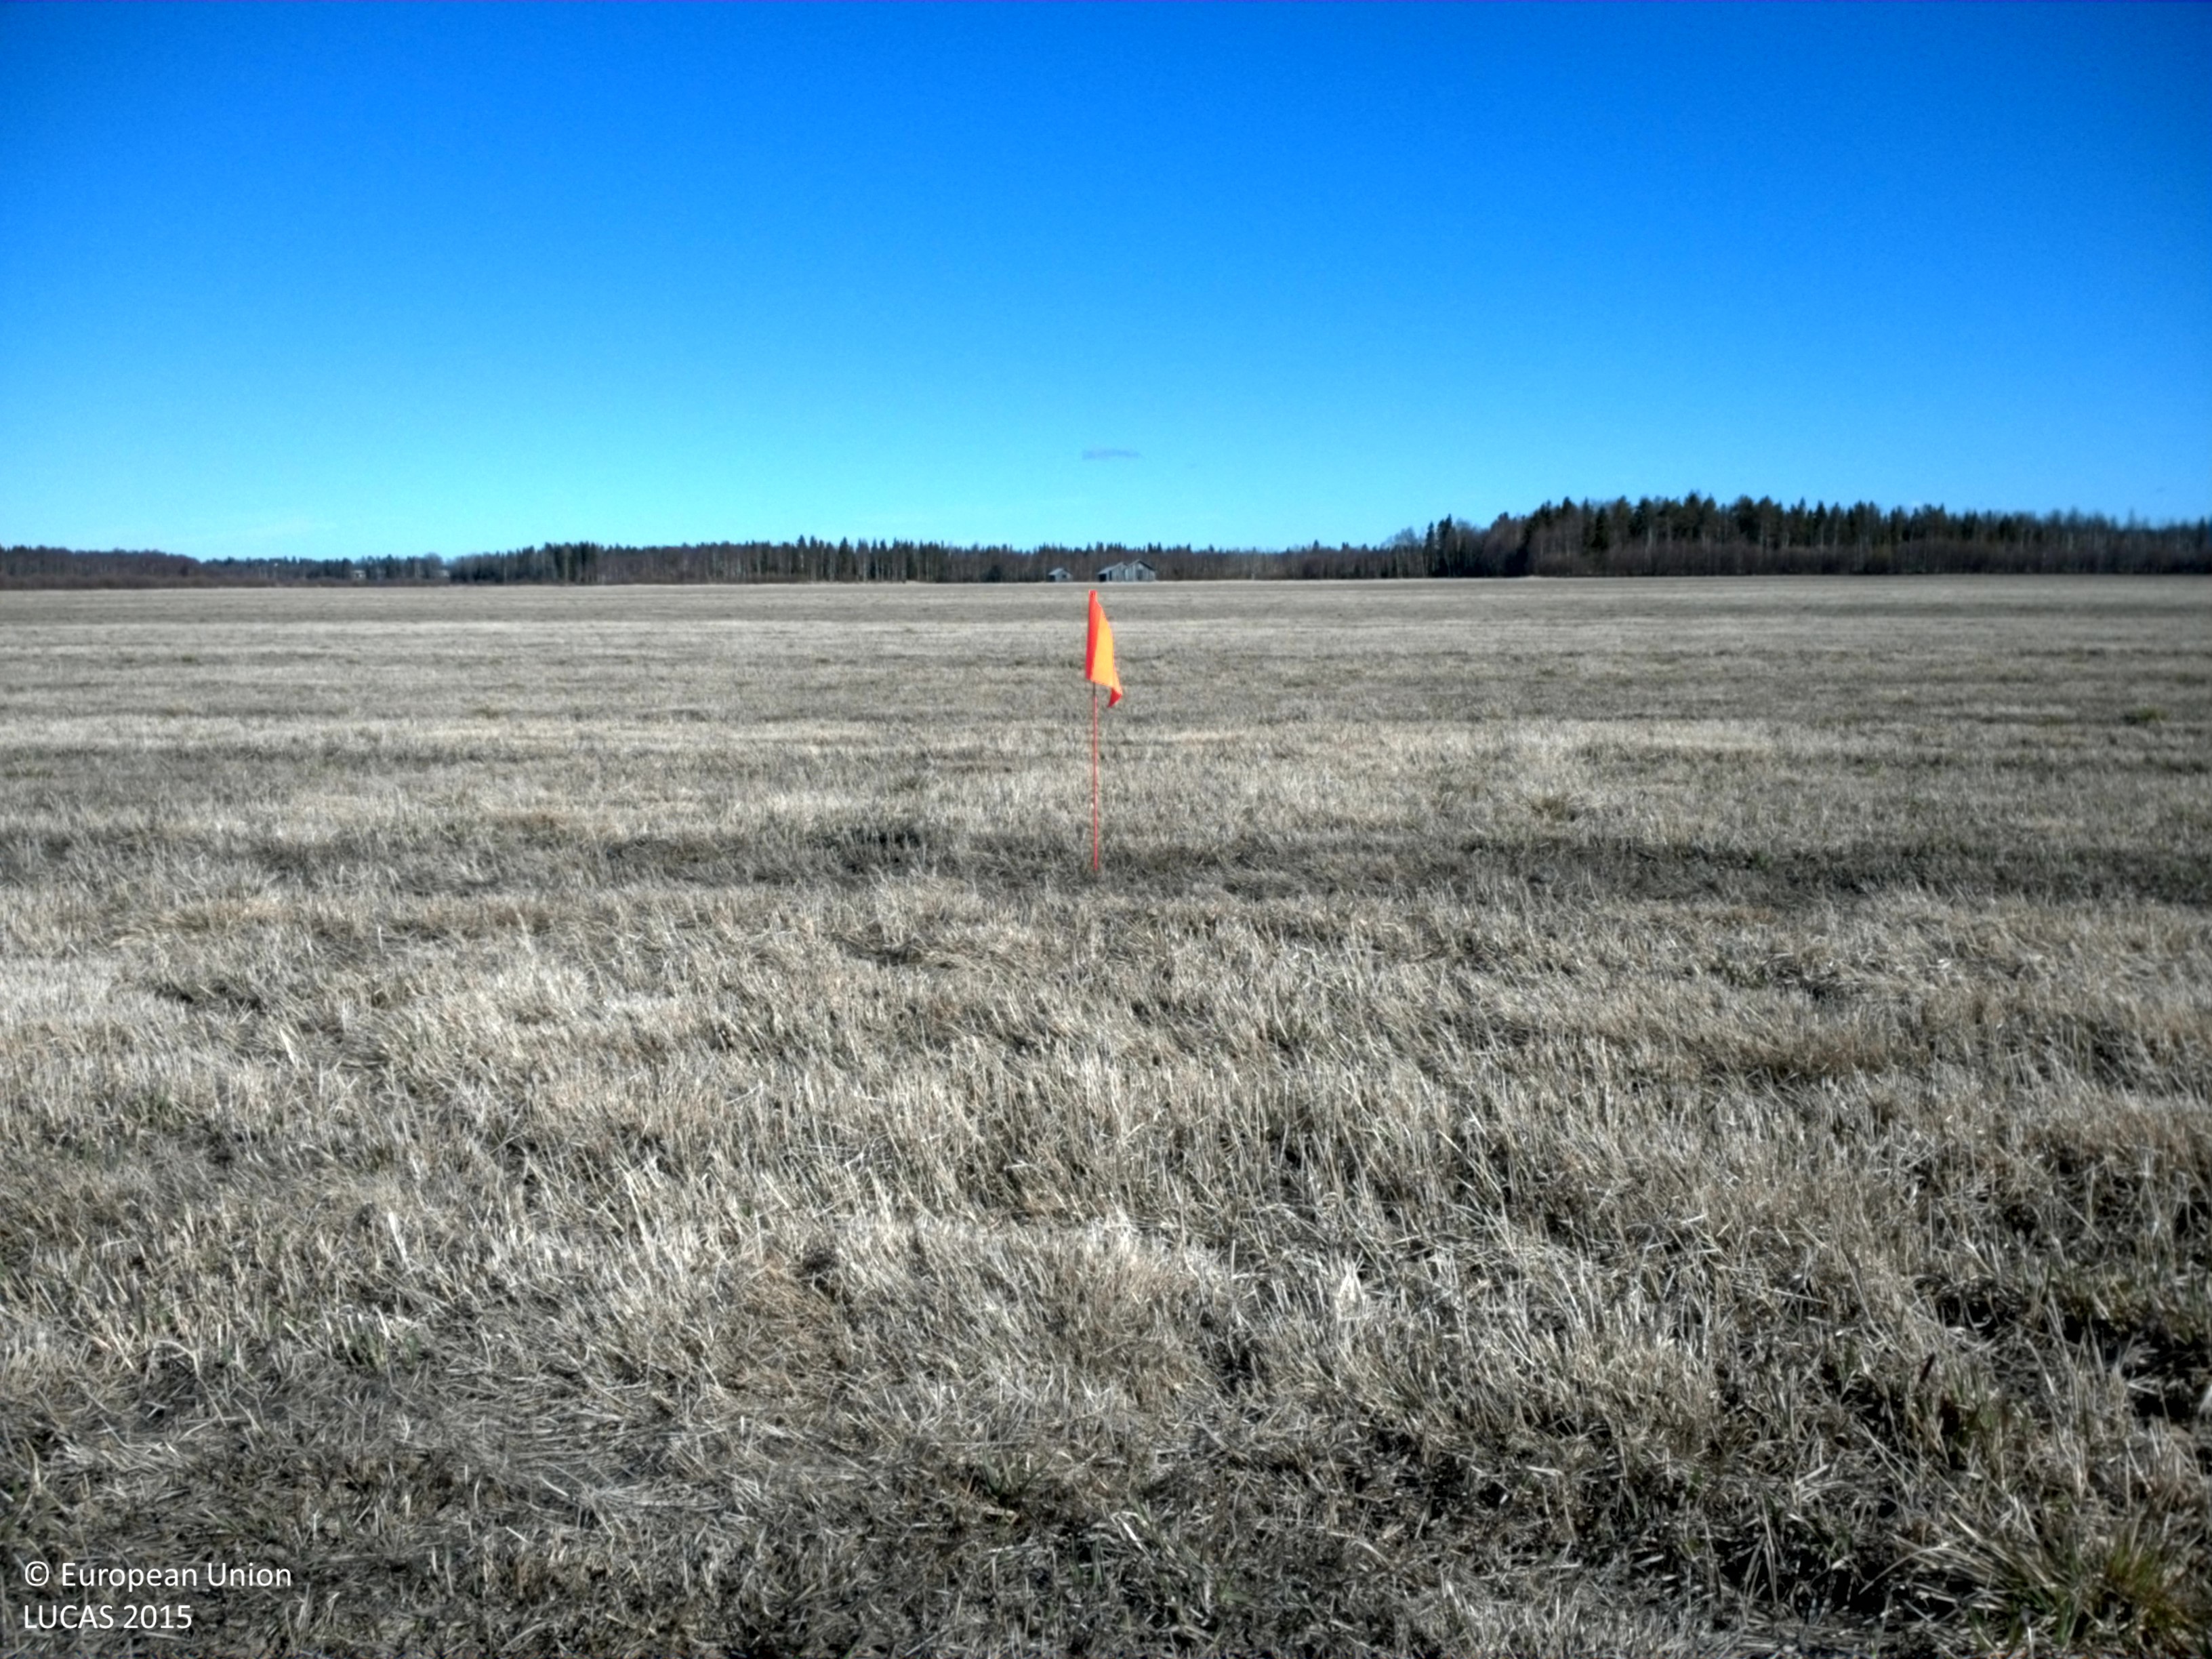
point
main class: Grassland
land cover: Grassland without tree/shrub cover
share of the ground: > 75 %
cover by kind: herbaceous plants 100 %
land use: Agriculture (excluding fallow land and kitchen gardens)
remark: Harvested field
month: May
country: SE
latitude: 65.8368
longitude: 23.1019
